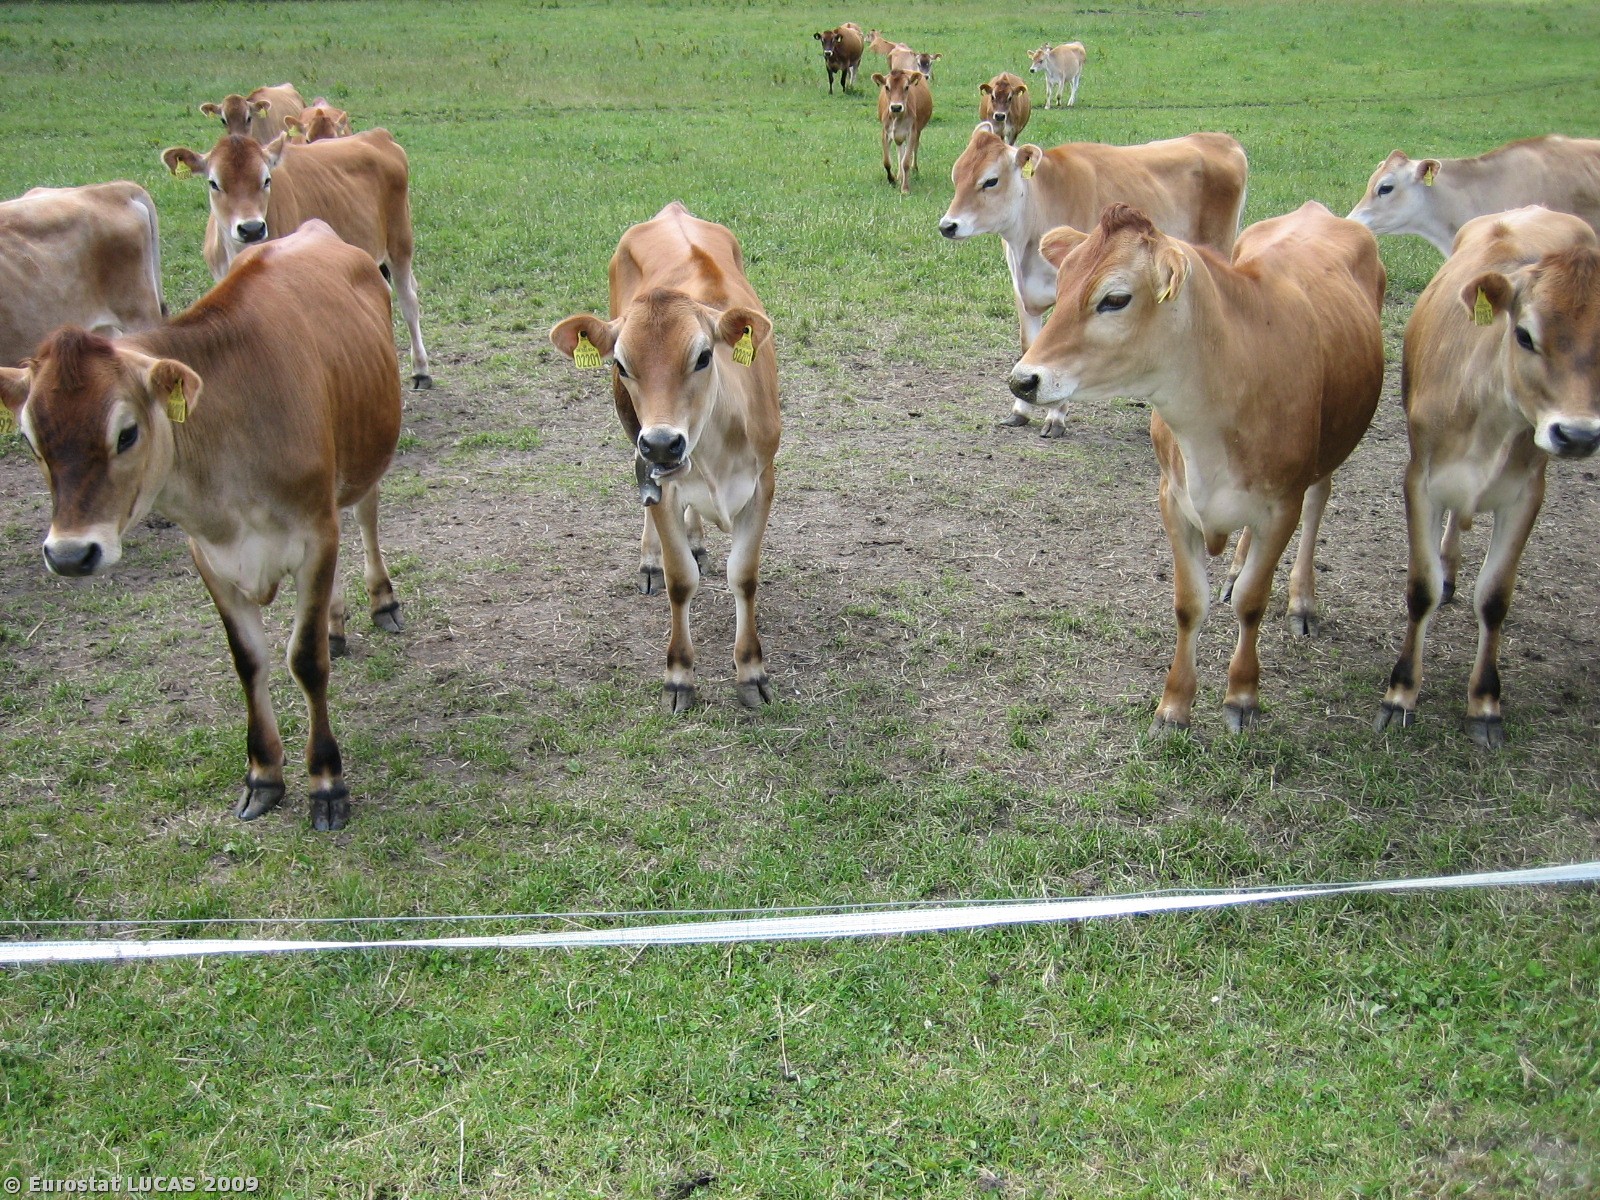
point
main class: Grassland
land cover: Grassland without tree/shrub cover
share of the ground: 10 - 25 %
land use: Agriculture (excluding fallow land and kitchen gardens)
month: June
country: DK
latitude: 55.7360
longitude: 9.2204
